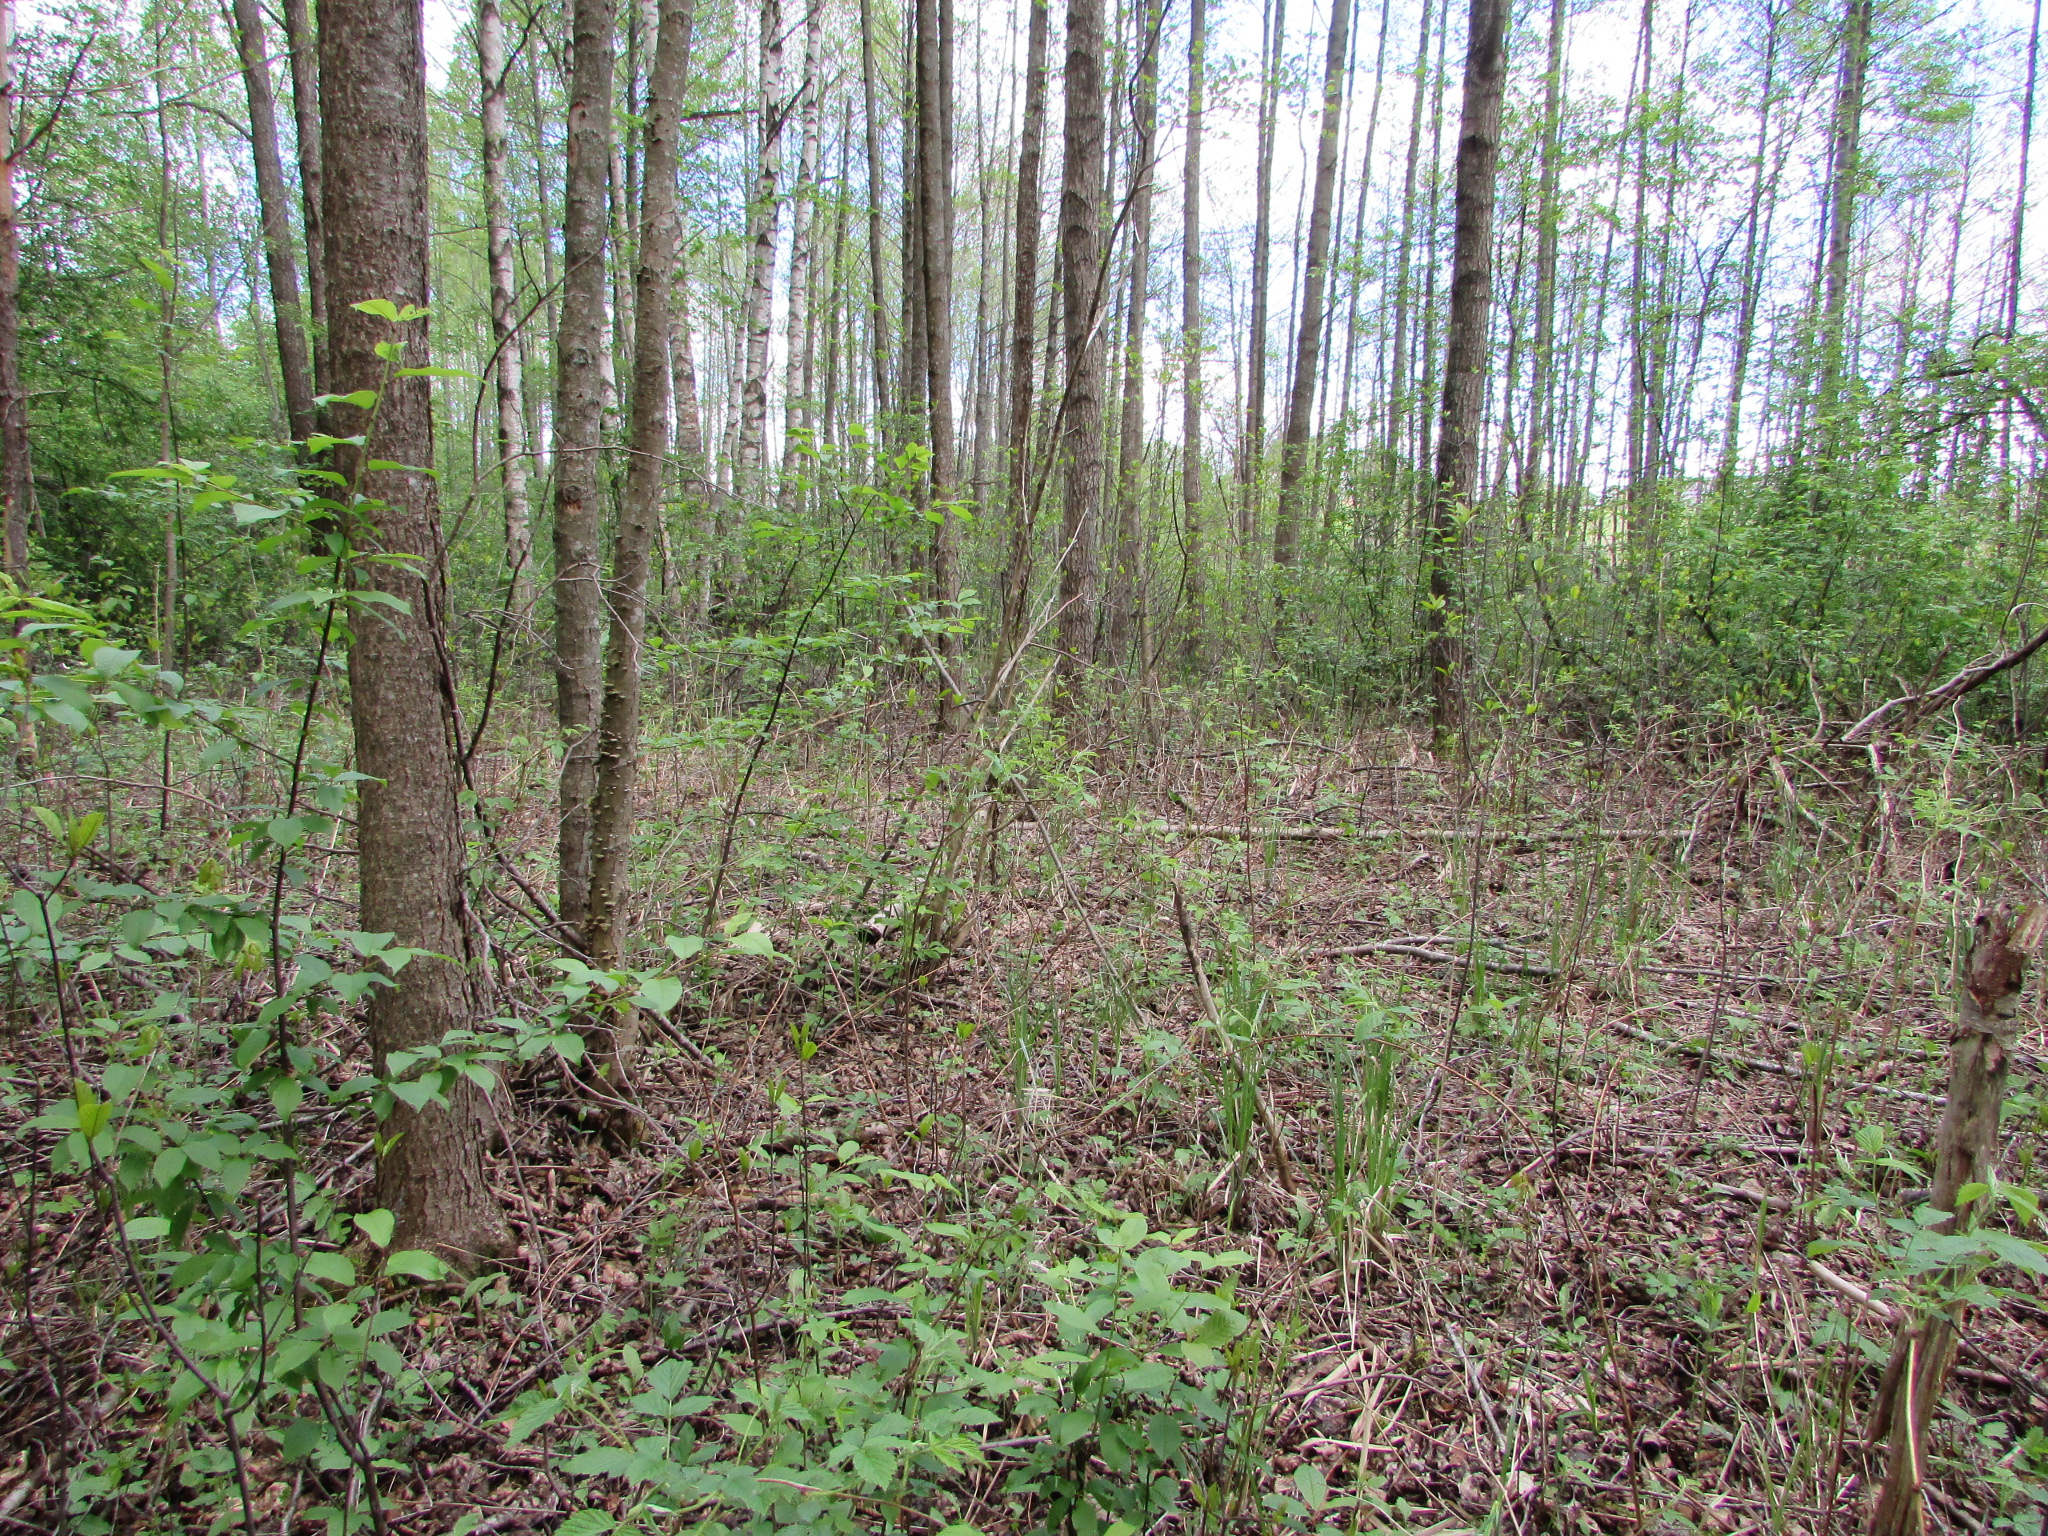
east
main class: Woodland
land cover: Pine dominated mixed woodland
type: hemiboreal forest and nemoral coniferous forest and mixed broadleaved-coniferous forest
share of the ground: > 75 %
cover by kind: coniferous forest trees 70 %, broadleaved forest trees 30 %
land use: Forestry
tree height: > 5 m
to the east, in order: Pine dominated mixed woodland; Ditches and canals; Spruce dominated mixed woodland; Grassland without tree/shrub cover; Broadleaved woodland; Grassland without tree/shrub cover; Tracks; Grassland without tree/shrub cover
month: May
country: LV
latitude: 56.1273
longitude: 27.2749
